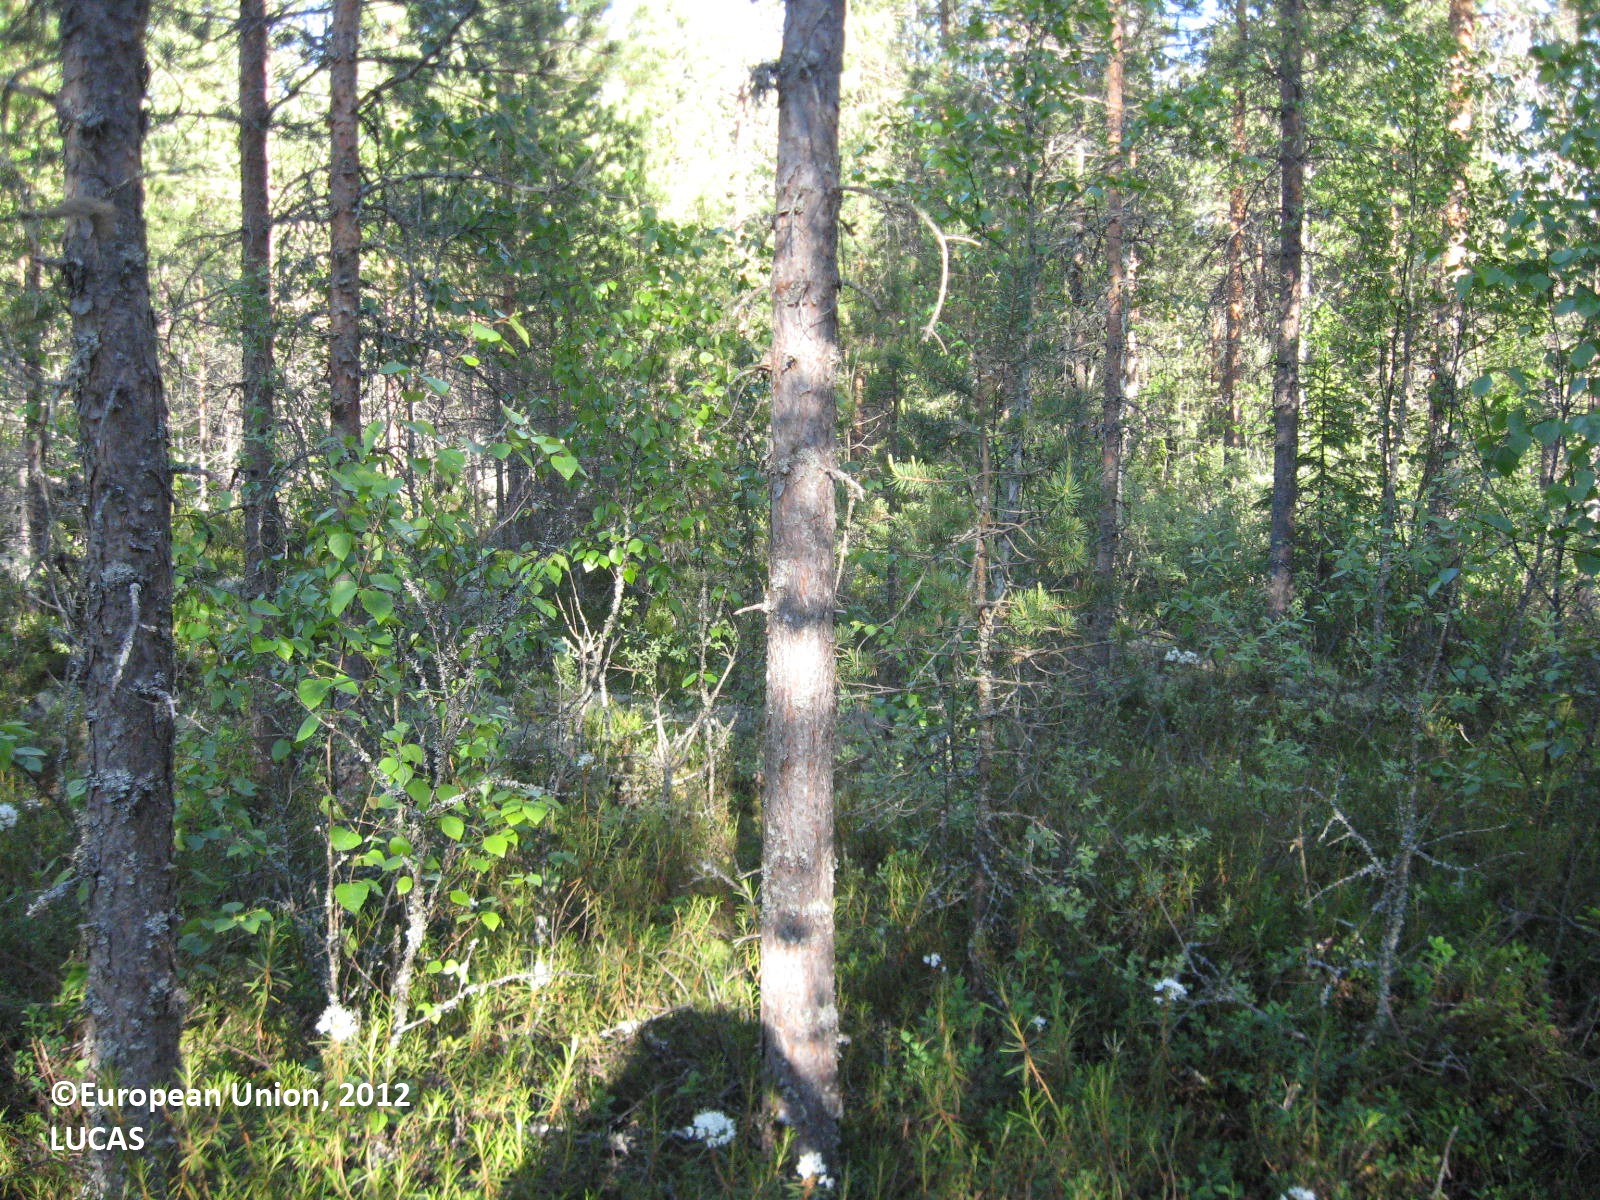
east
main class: Woodland
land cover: Pine dominated coniferous woodland
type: boreal forest
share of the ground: > 75 %
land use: Forestry
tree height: > 5 m
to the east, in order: Pine dominated coniferous woodland; Shruby margins; Paved roads, cycling and walking lanes; Shruby margins; Spruce dominated mixed woodland; Ditches and canals; Spruce dominated mixed woodland; Ditches and canals; Pine dominated mixed woodland
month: June
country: FI
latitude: 62.8584
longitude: 21.5752
